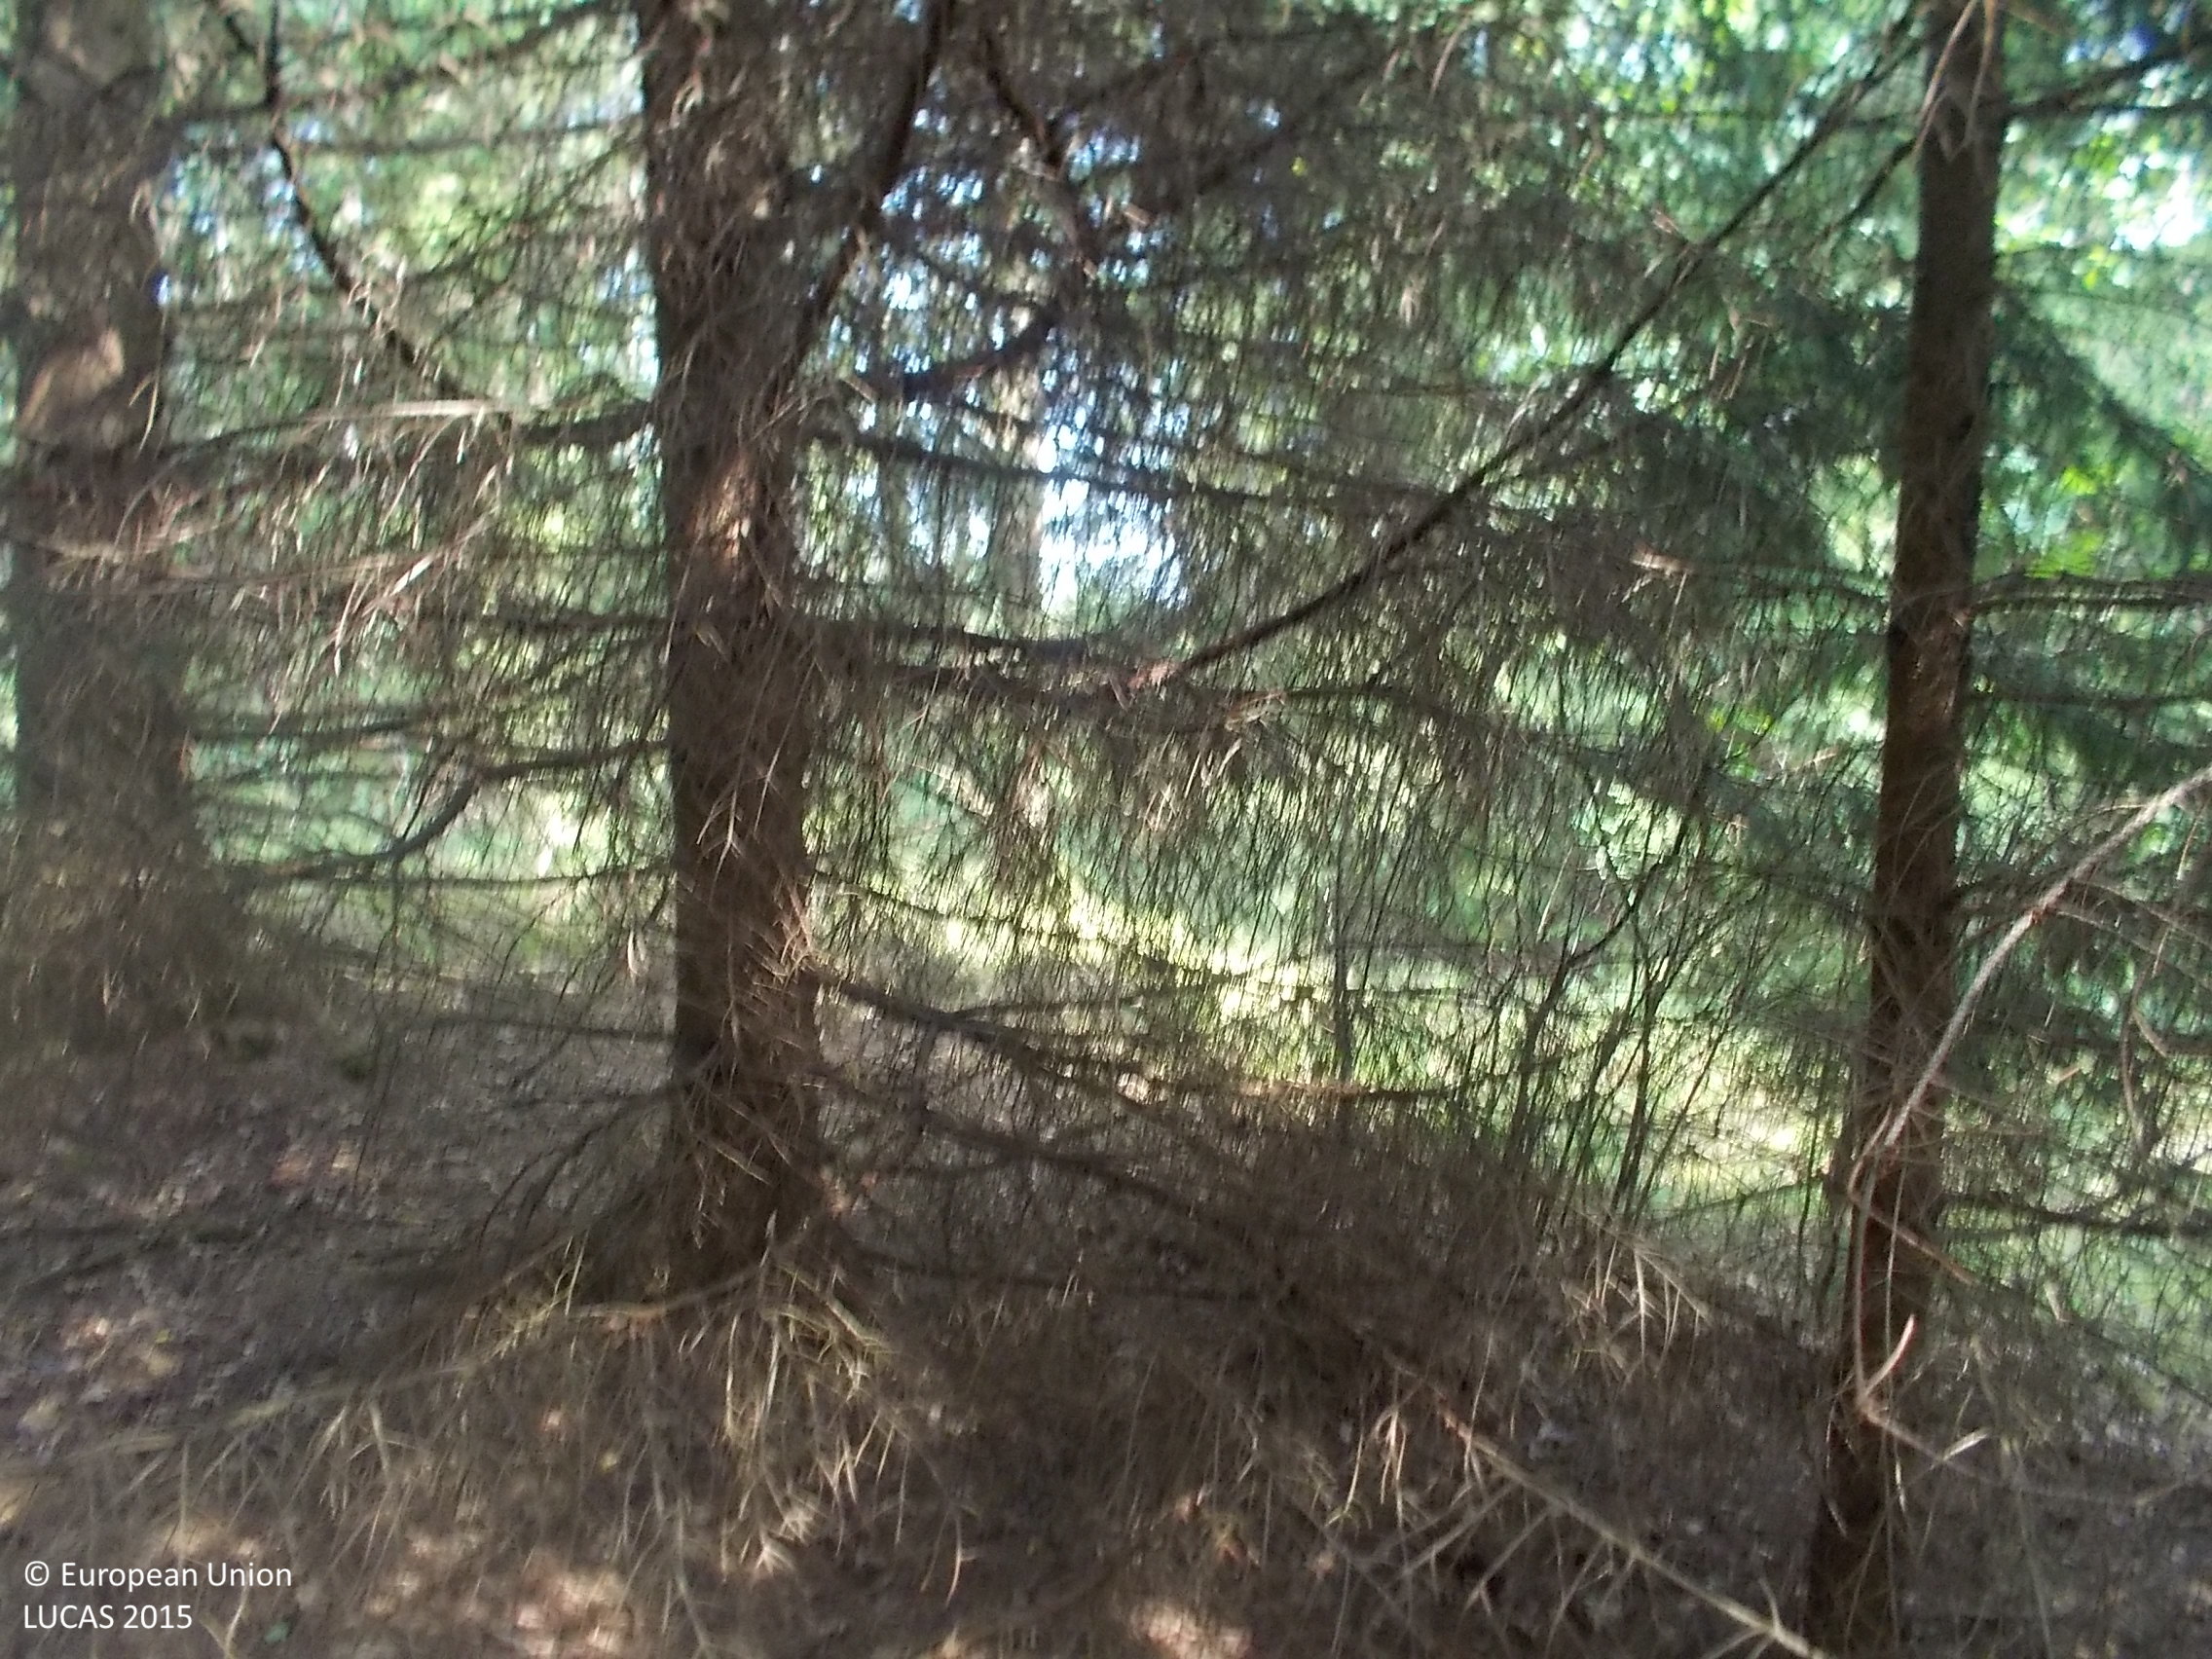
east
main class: Woodland
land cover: Spruce dominated coniferous woodland
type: boreal forest
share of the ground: > 75 %
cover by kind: coniferous forest trees 95 %, lichens and mosses 5 %
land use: Forestry
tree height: > 5 m
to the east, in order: Spruce dominated coniferous woodland; Spruce dominated mixed woodland; Shrubland without tree cover; Spruce dominated coniferous woodland; Broadleaved woodland; Spruce dominated mixed woodland; Spruce dominated coniferous woodland; Tracks; Spruce dominated coniferous woodland
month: August
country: SE
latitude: 57.4823
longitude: 13.0814
